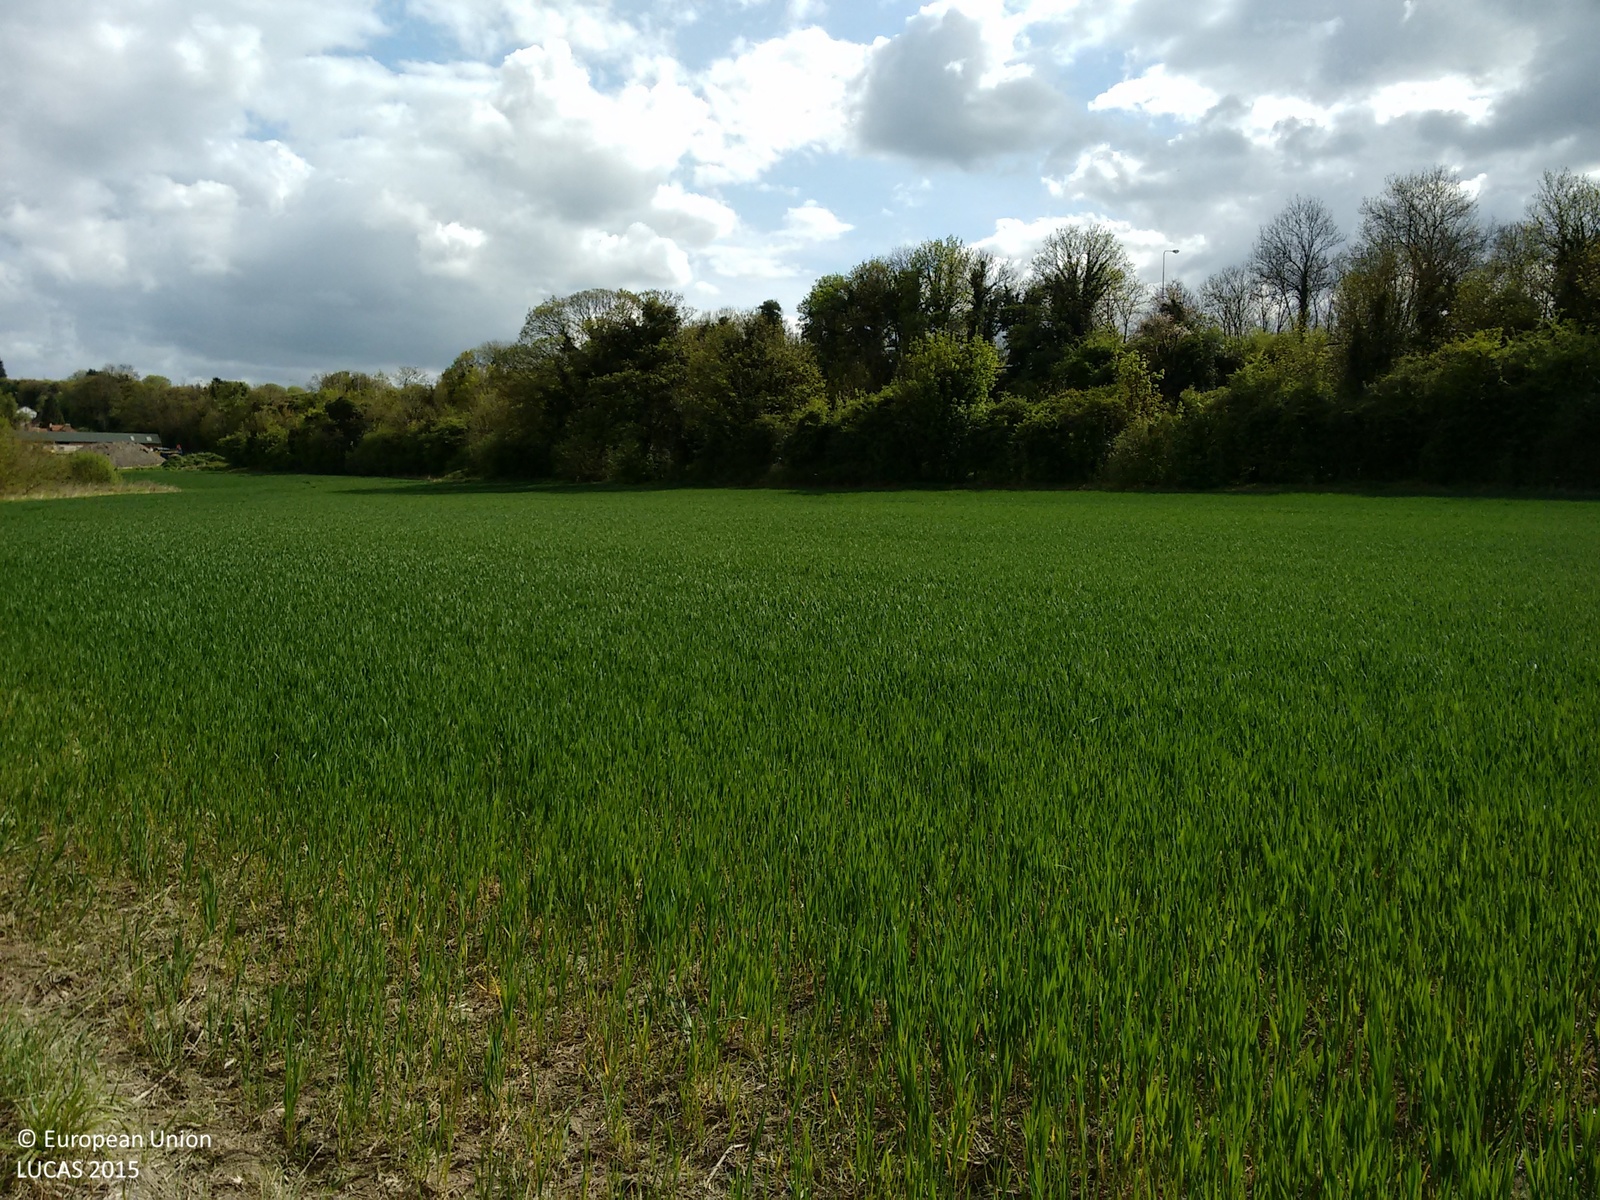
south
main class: Woodland
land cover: Broadleaved woodland
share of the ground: > 75 %
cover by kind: broadleaved forest trees 50 %, herbaceous plants 50 %
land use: Semi-natural and natural areas not in use
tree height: < 5 m
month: May
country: GB
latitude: 51.9062
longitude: -0.5480
